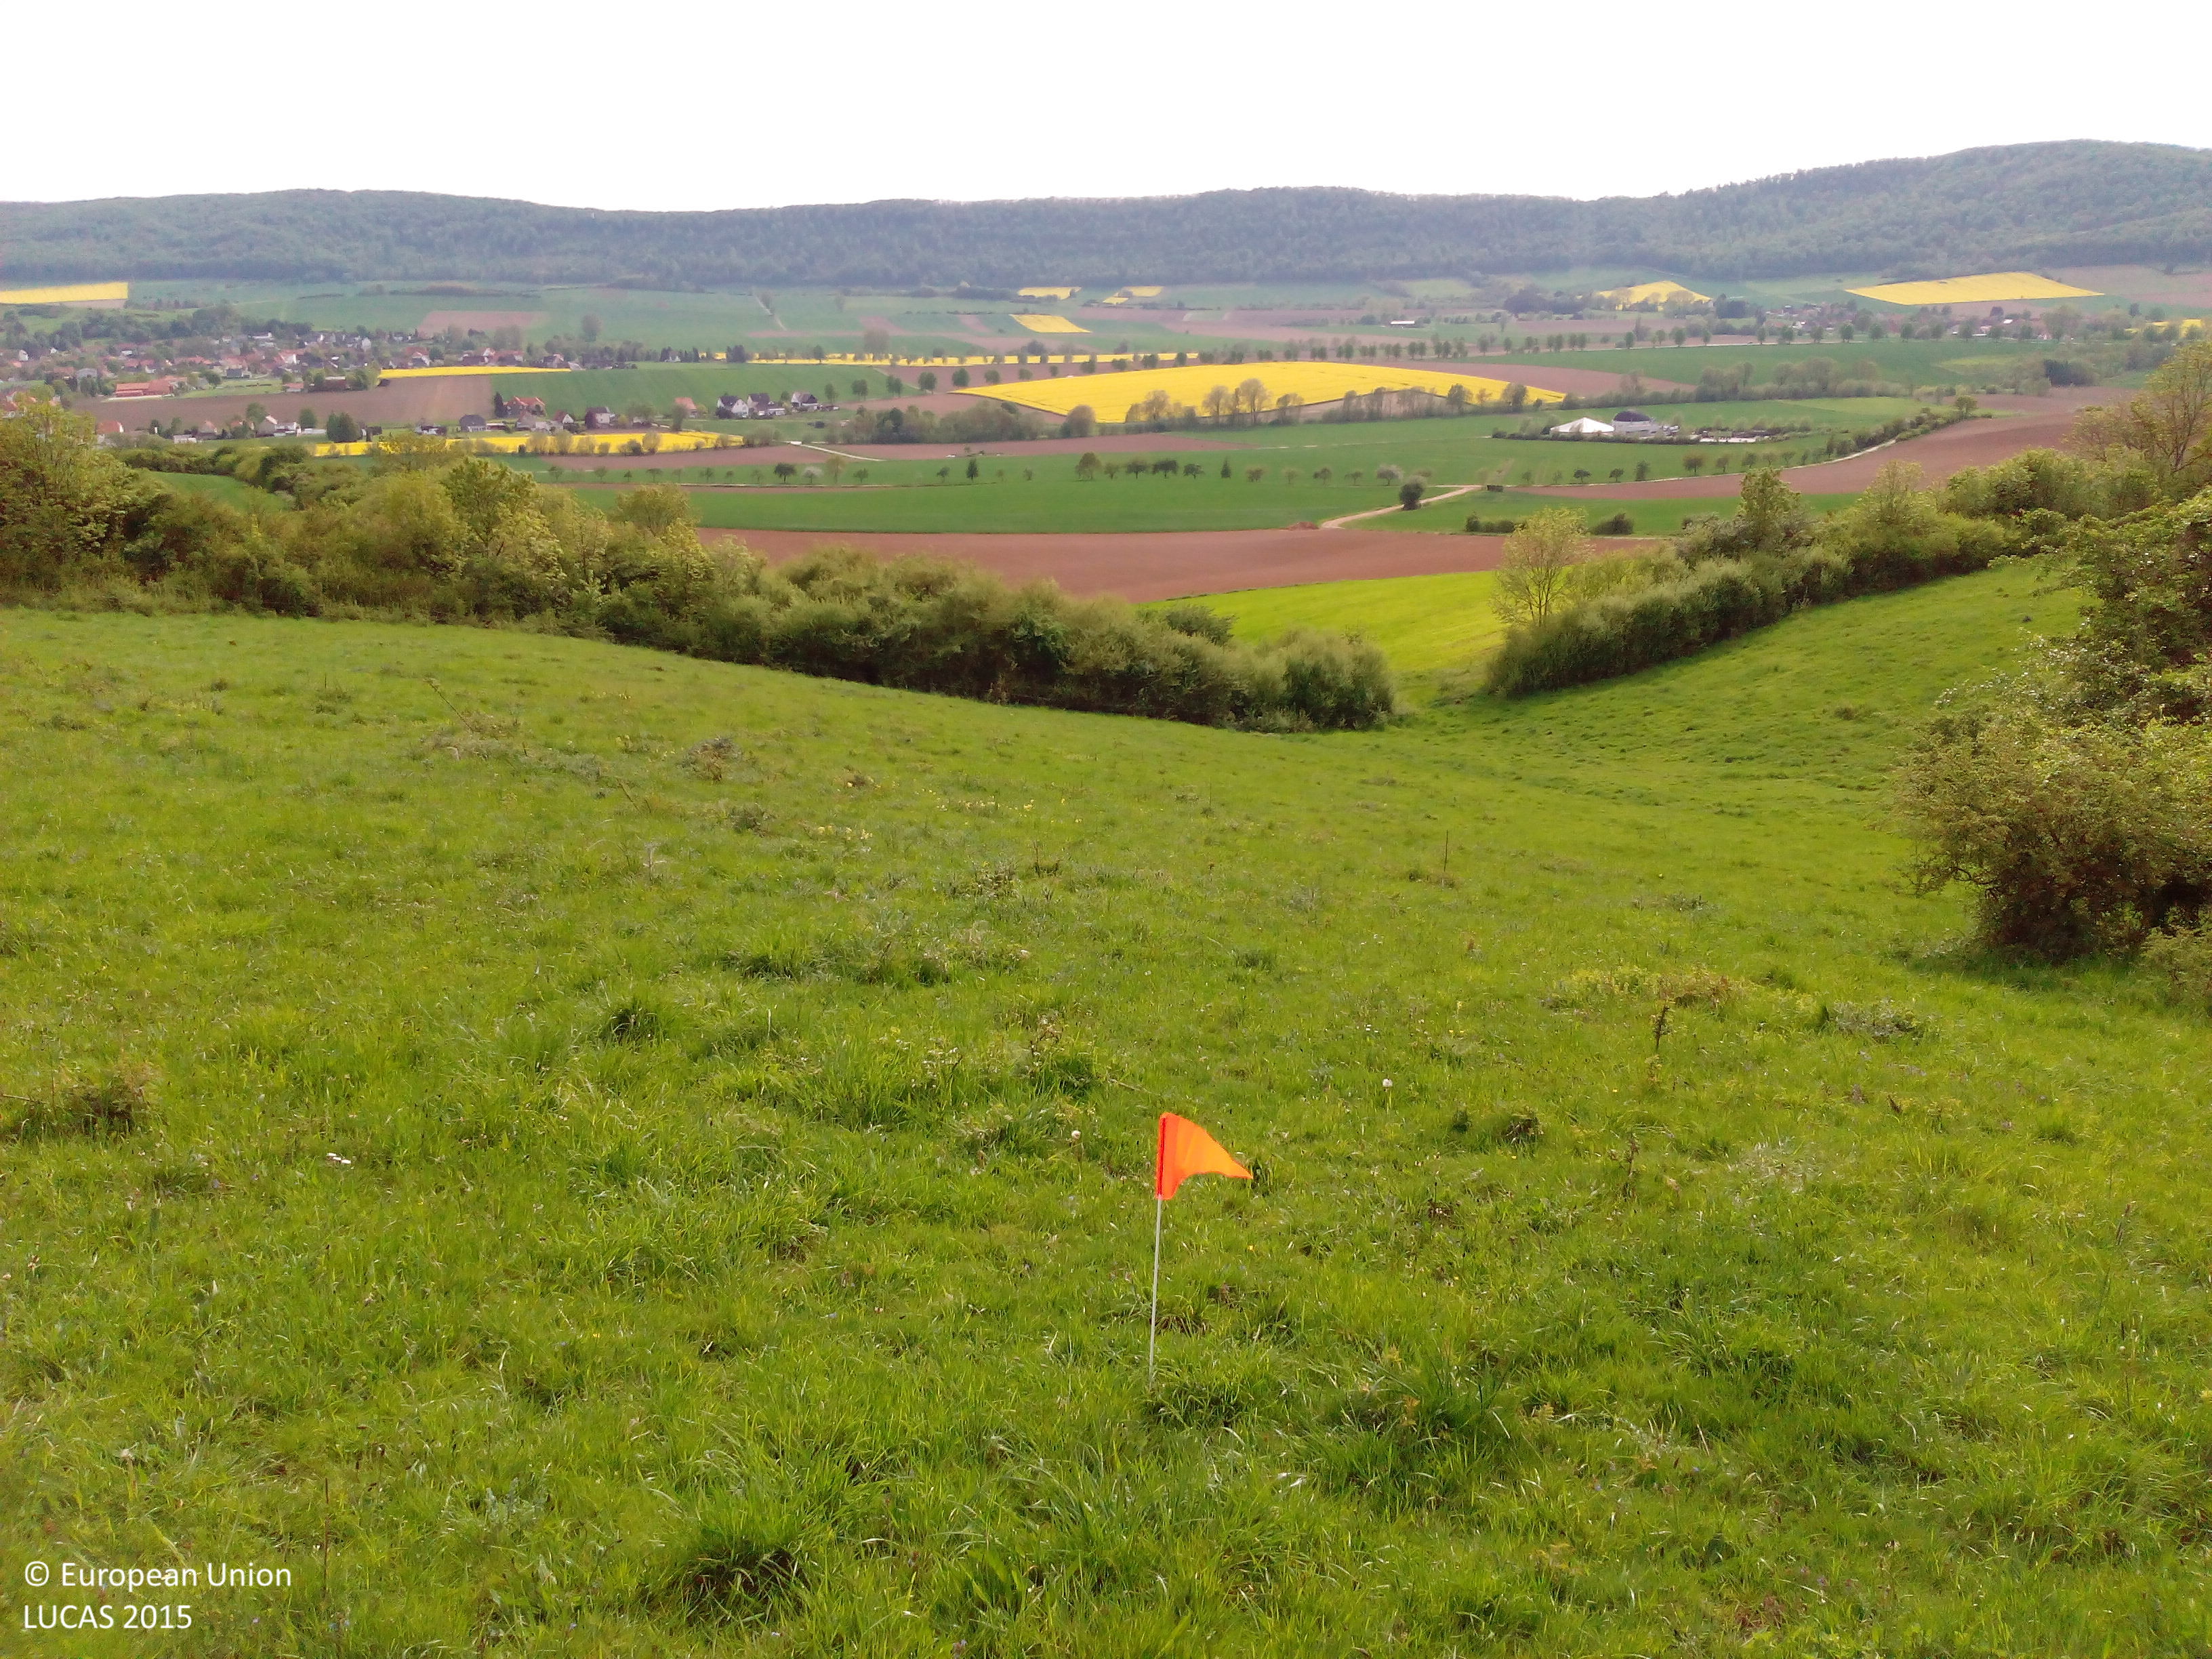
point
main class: Grassland
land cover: Grassland without tree/shrub cover
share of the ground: > 75 %
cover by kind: herbaceous plants 100 %
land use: Agriculture (excluding fallow land and kitchen gardens)
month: May
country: DE
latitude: 52.0354
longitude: 9.6357
